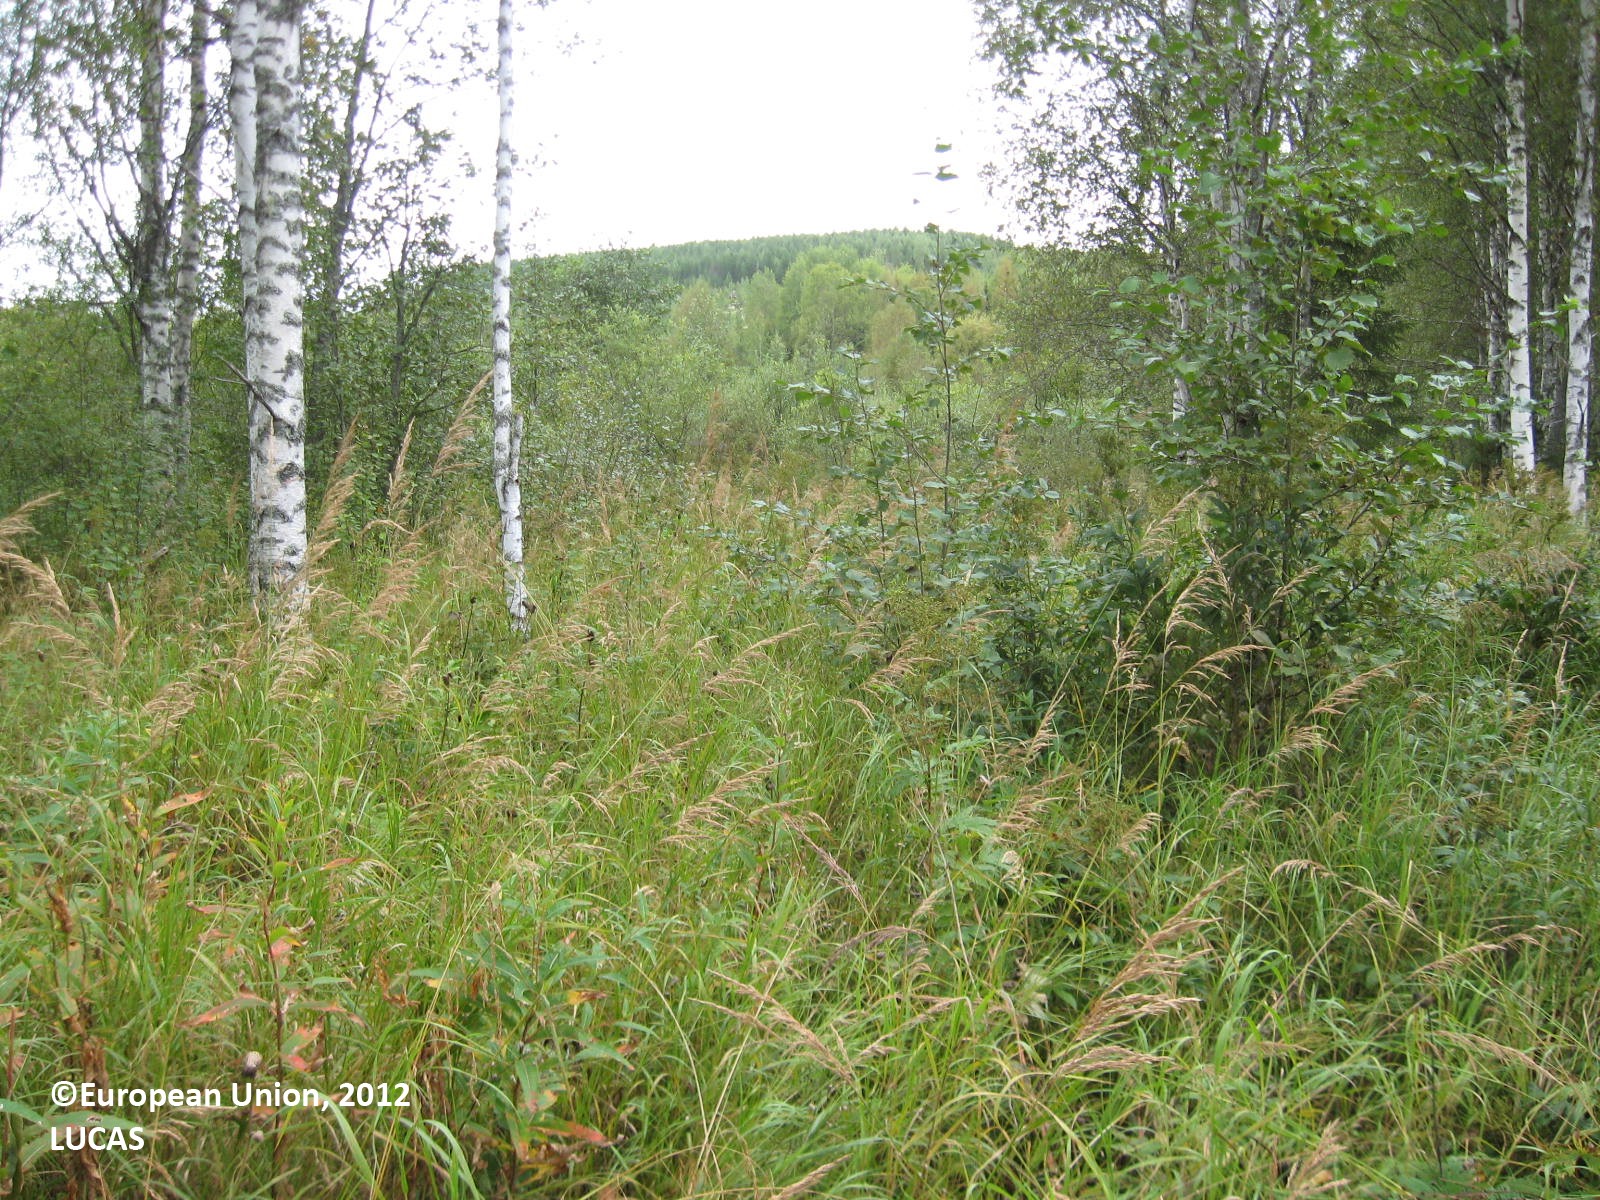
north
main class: Woodland
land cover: Broadleaved woodland
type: boreal forest
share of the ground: 25 - 50 %
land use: Forestry
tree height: > 5 m
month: August
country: FI
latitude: 63.6851
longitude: 29.1141
